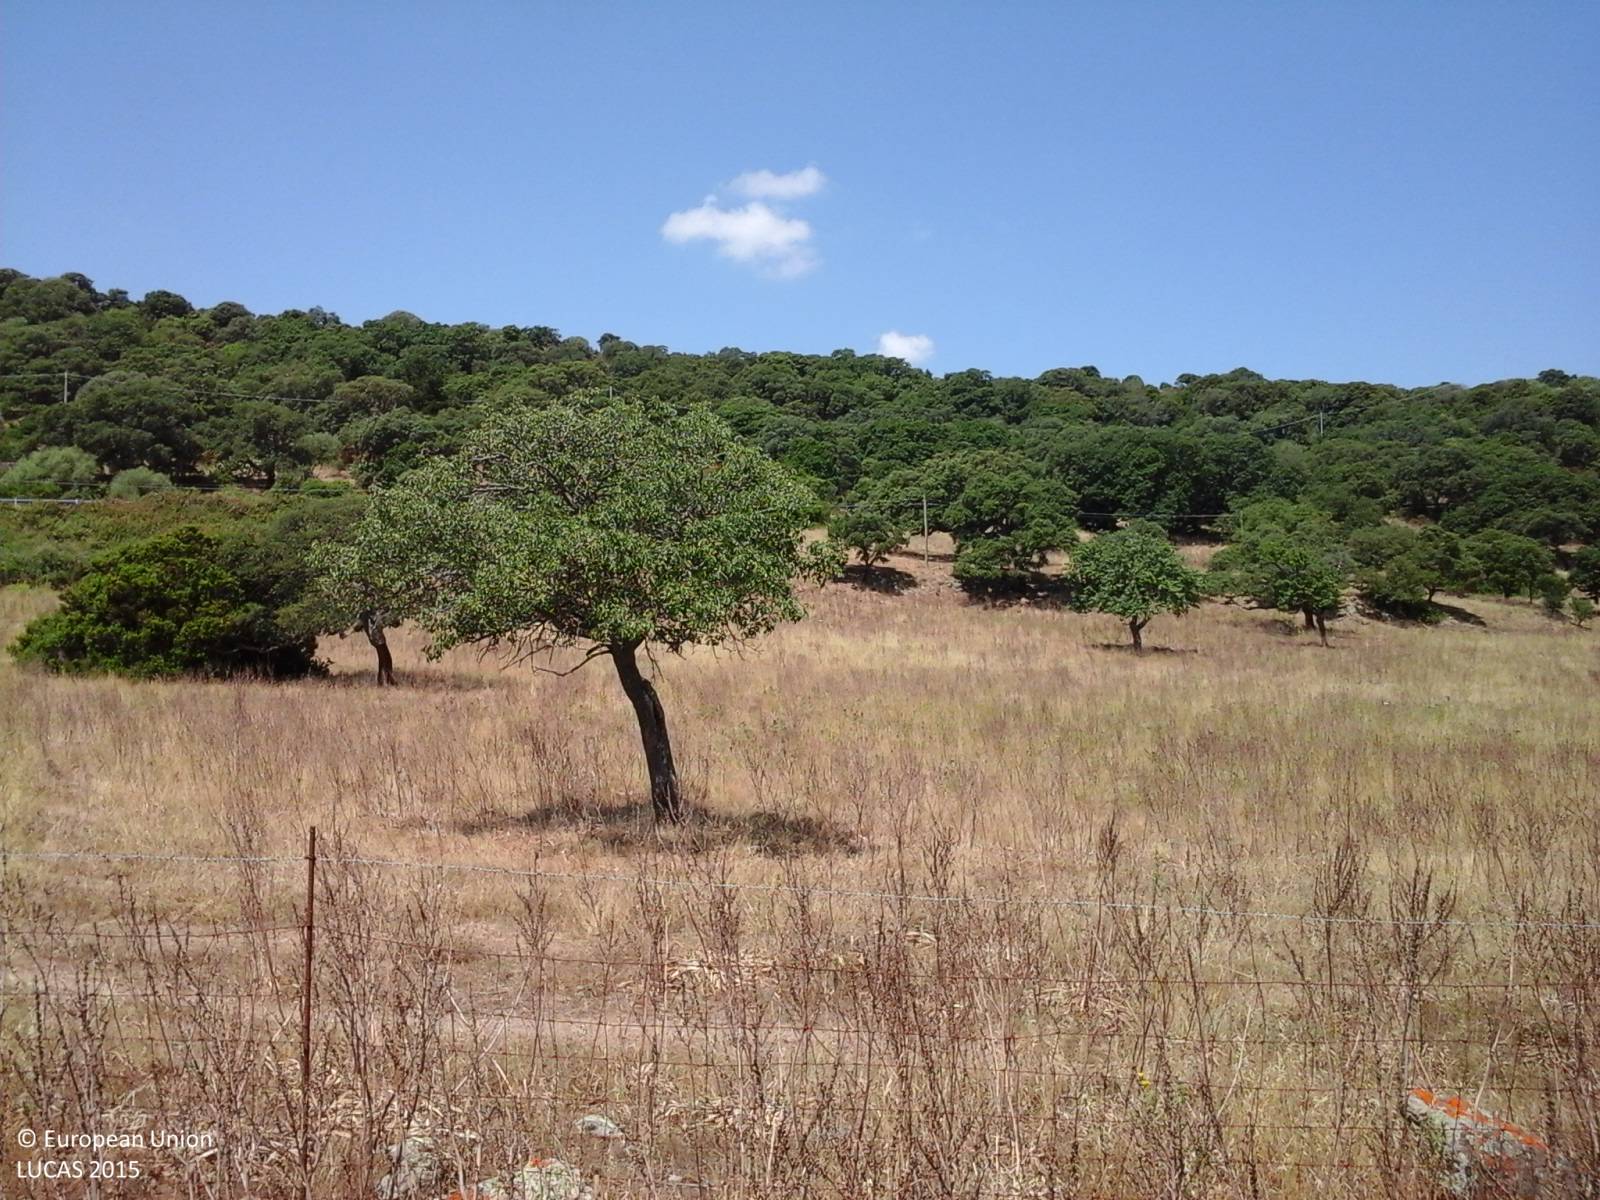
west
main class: Grassland
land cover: Grassland without tree/shrub cover
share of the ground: > 75 %
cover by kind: herbaceous plants 95 %, shrubs 5 %
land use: Agriculture (excluding fallow land and kitchen gardens)
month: June
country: IT
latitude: 40.7494
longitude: 8.8567
